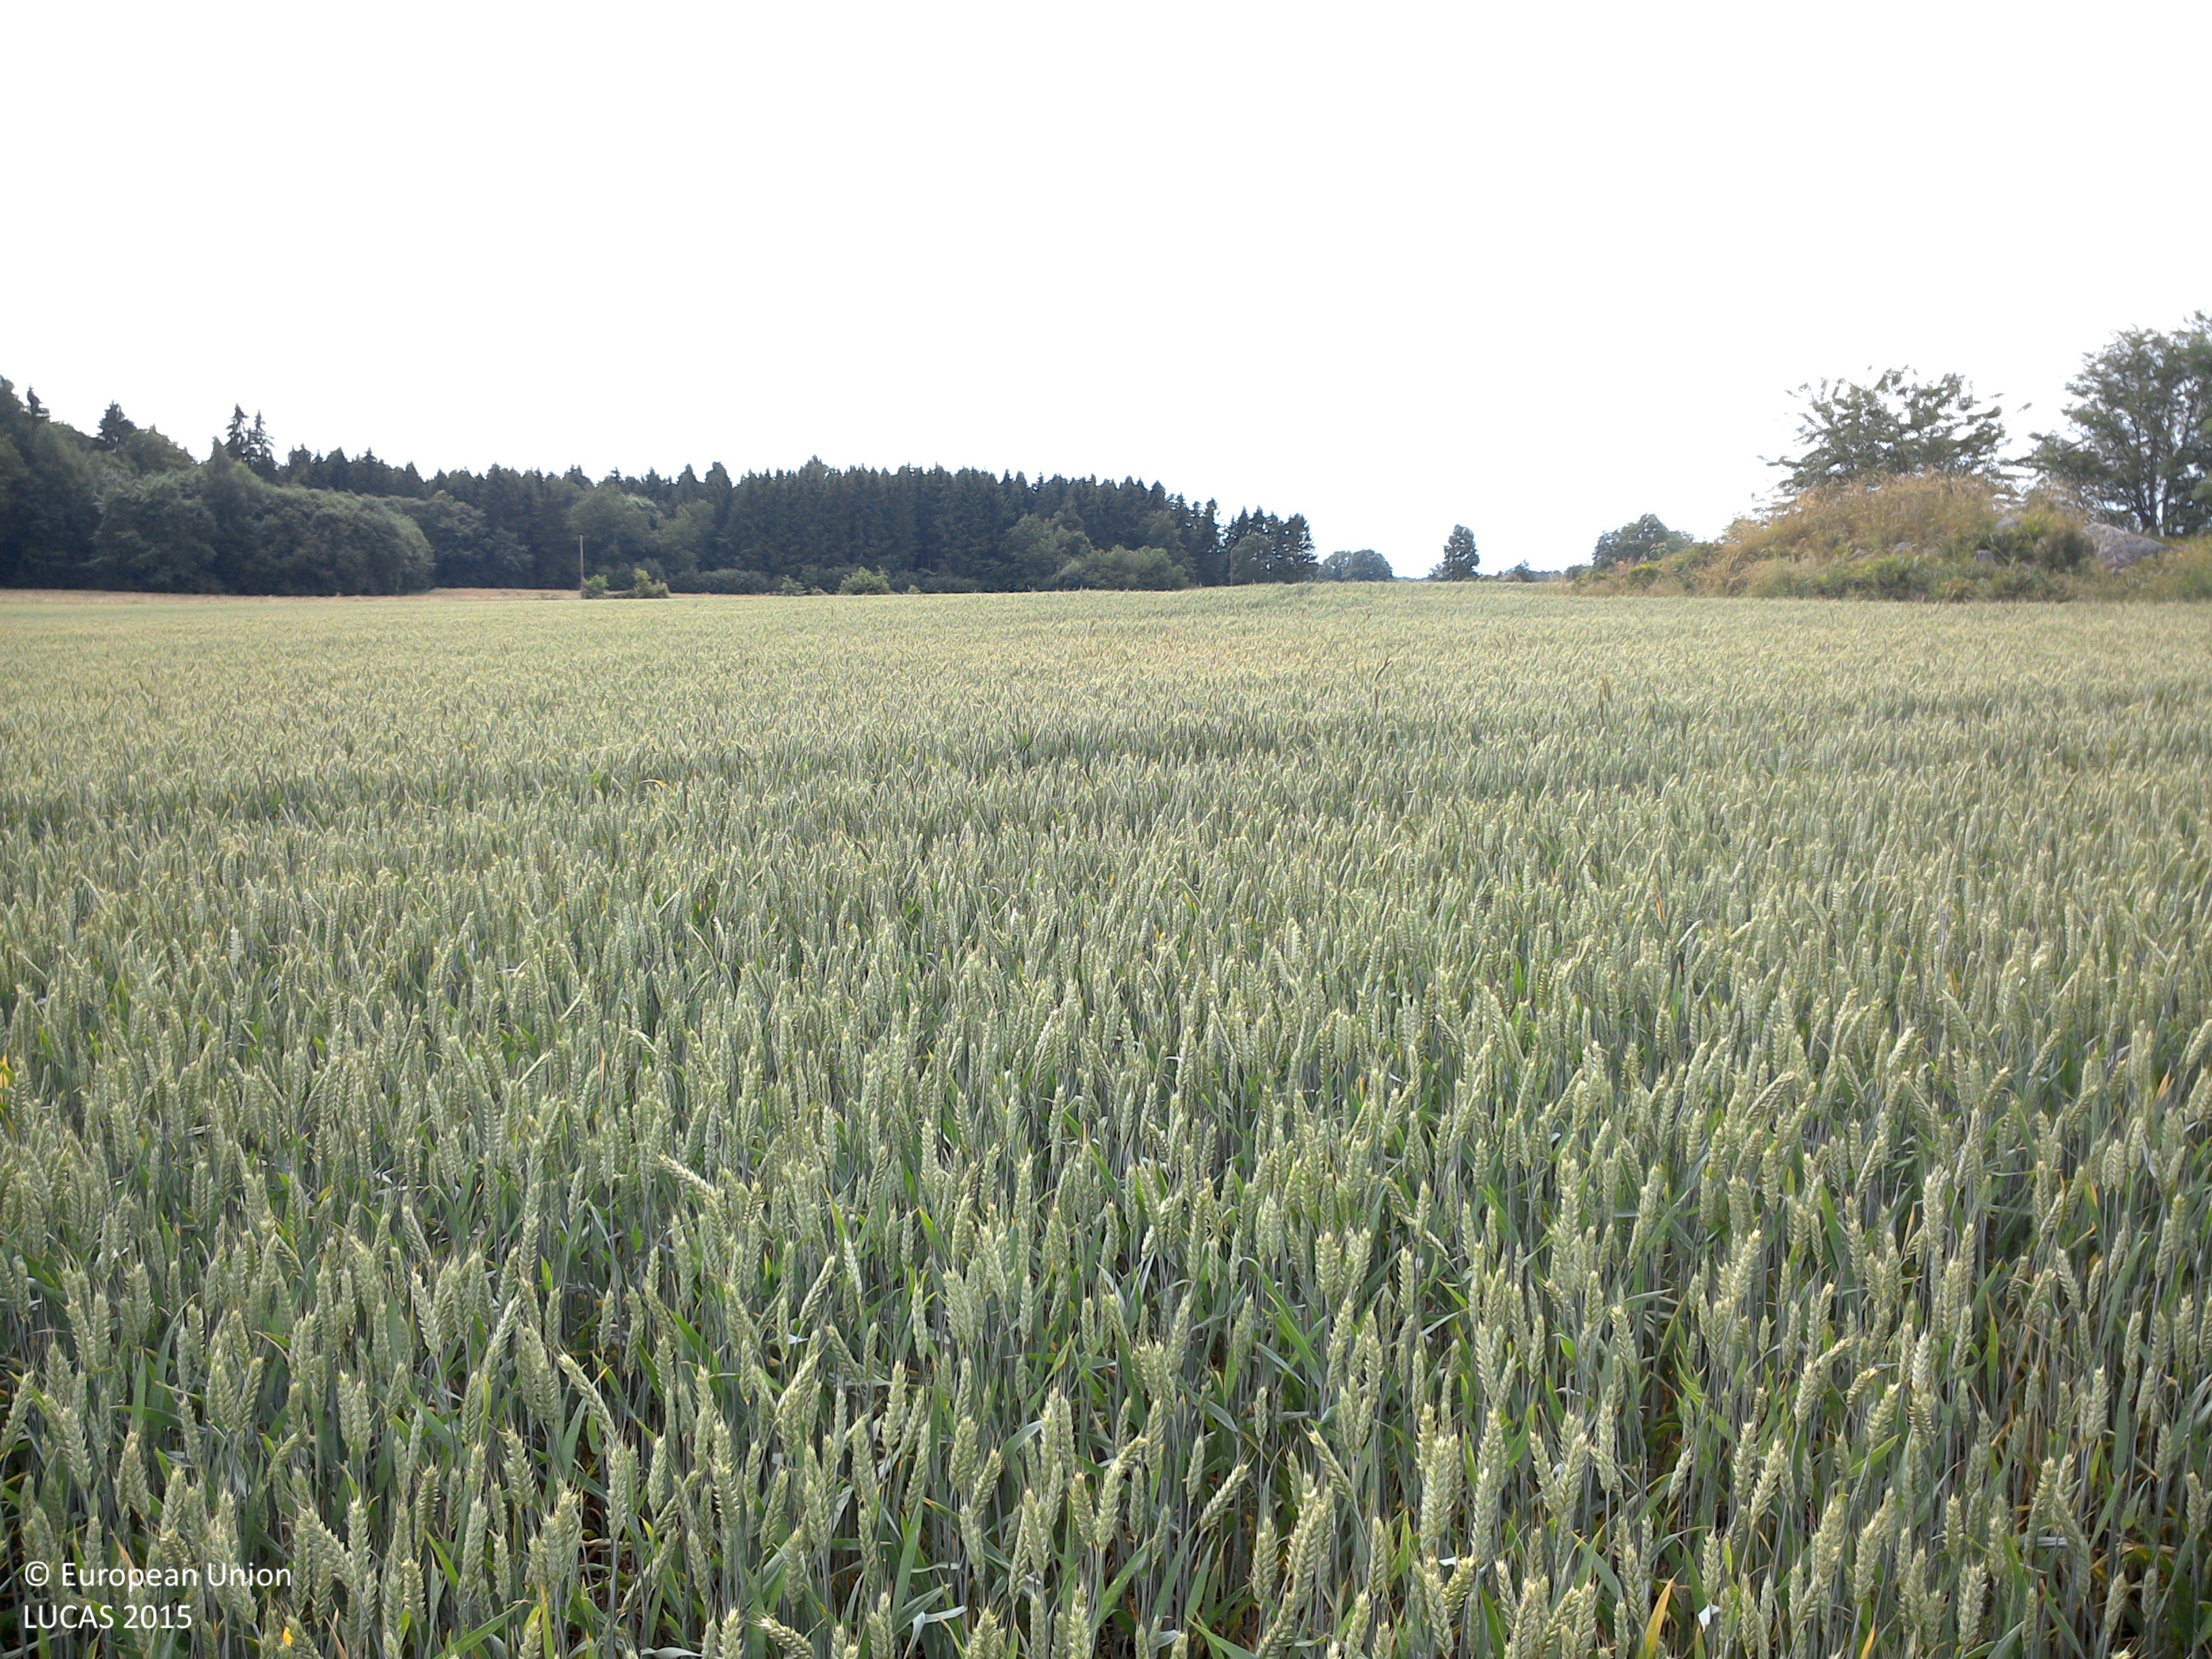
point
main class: Cropland
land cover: Common wheat
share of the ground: > 75 %
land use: Agriculture (excluding fallow land and kitchen gardens)
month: July
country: SE
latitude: 58.2630
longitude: 14.7154
